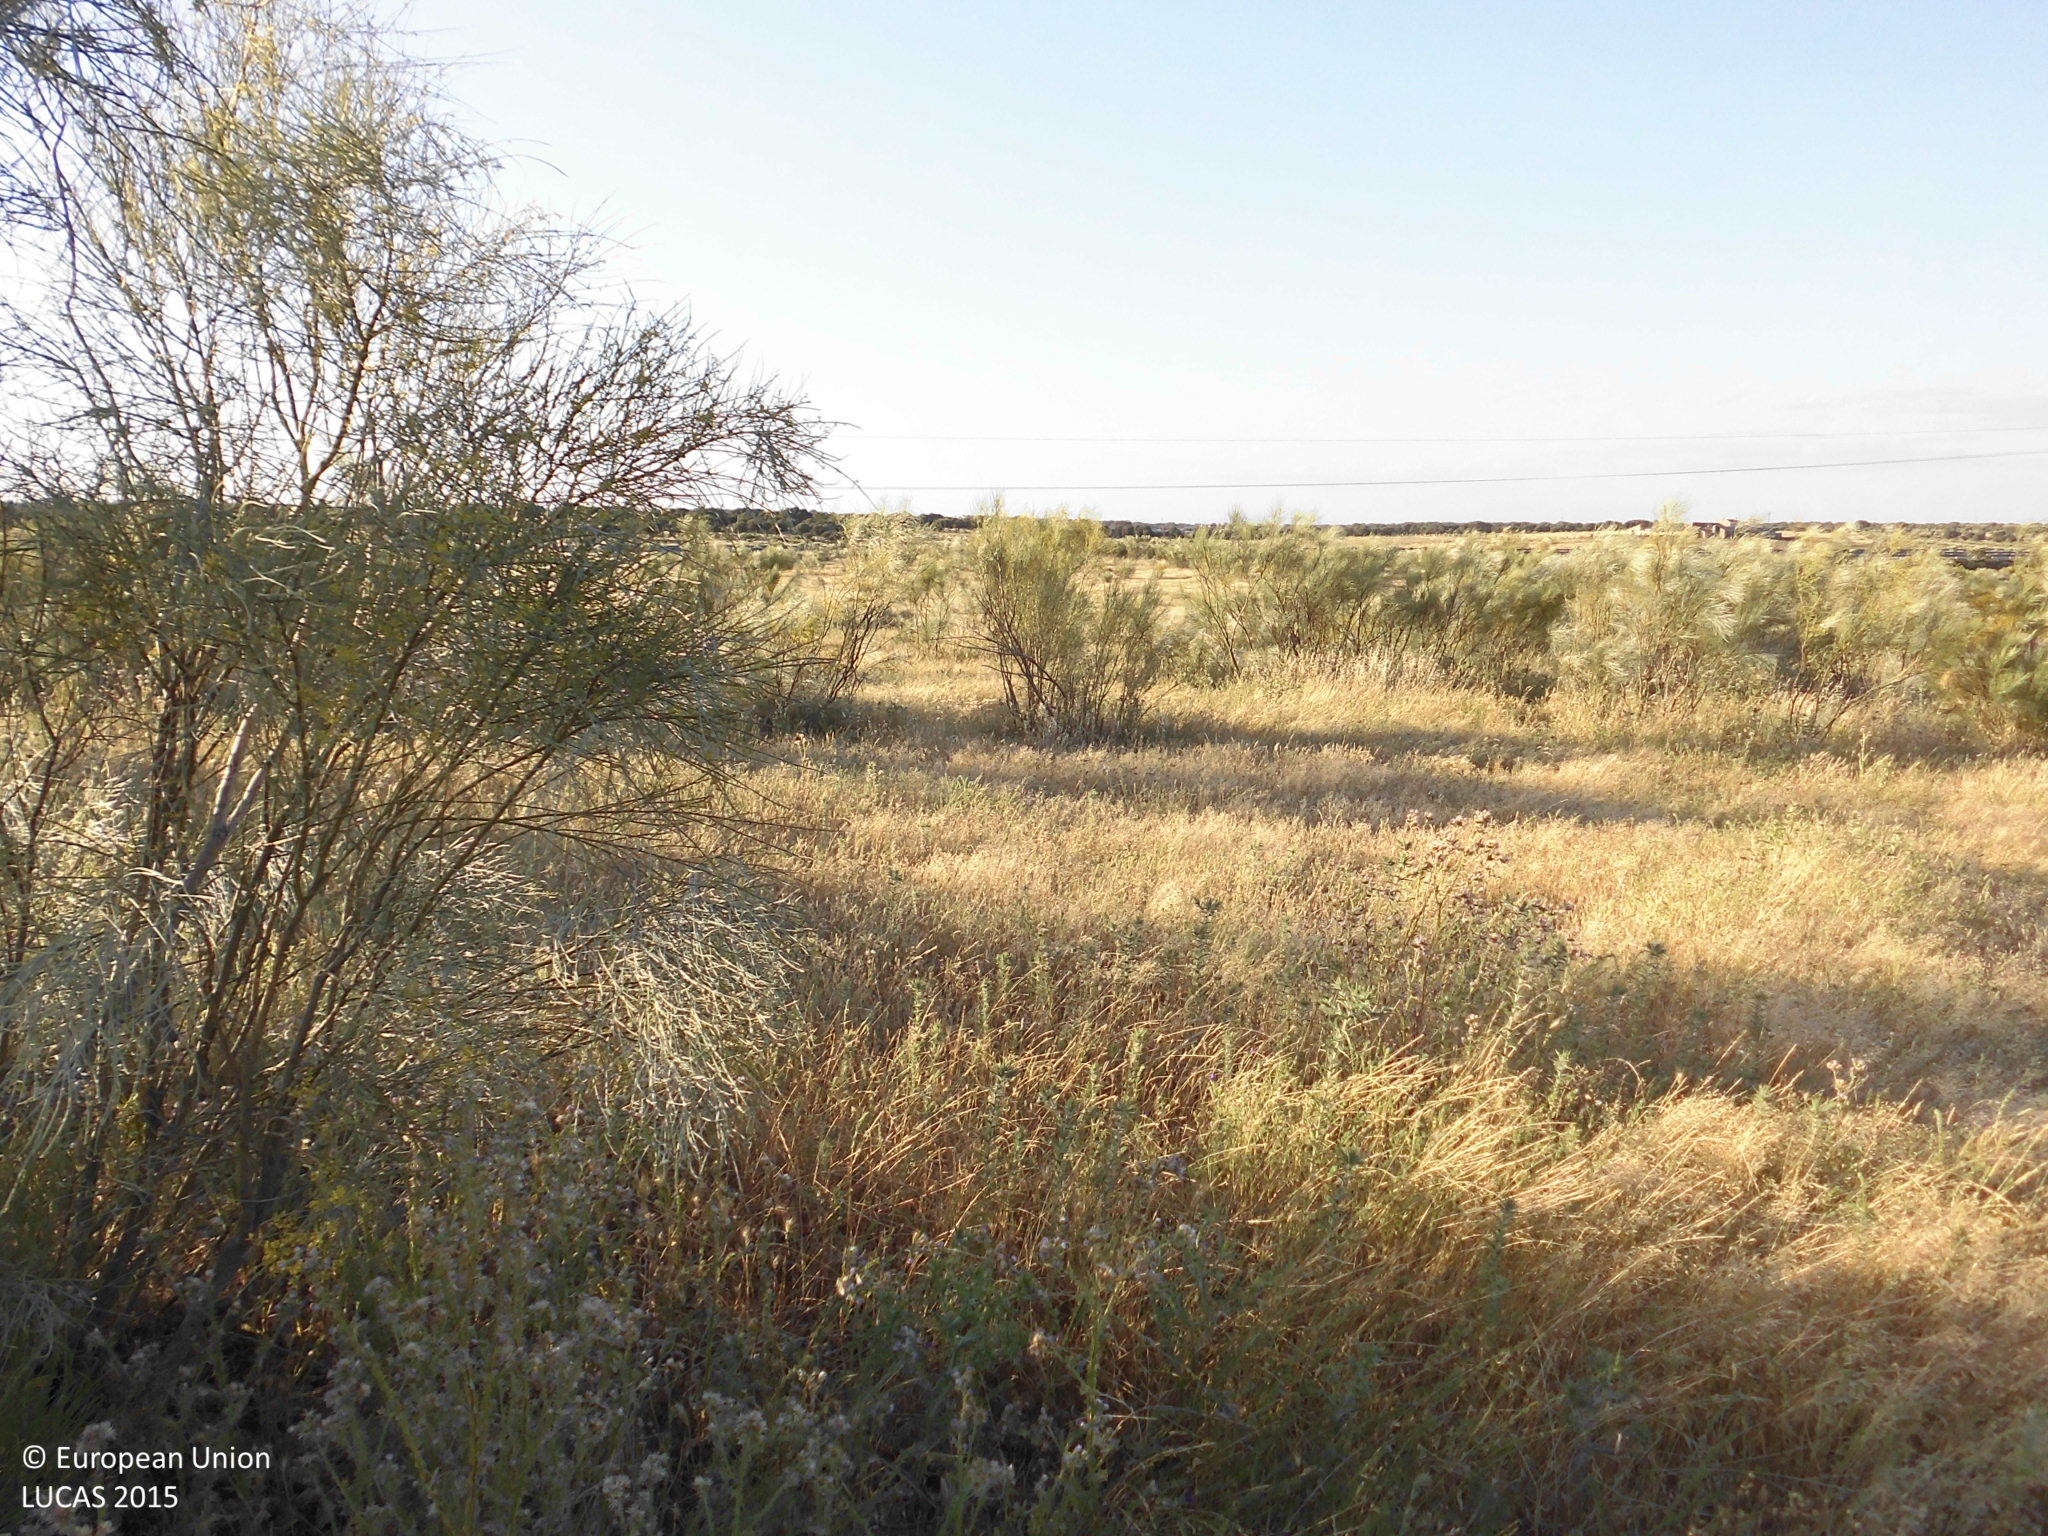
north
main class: Shrubland
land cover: Shrubland without tree cover
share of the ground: 10 - 25 %
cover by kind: herbaceous plants 85 %, shrubs 15 %
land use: Agriculture (excluding fallow land and kitchen gardens)
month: May
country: ES
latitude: 39.4394
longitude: -6.0130
